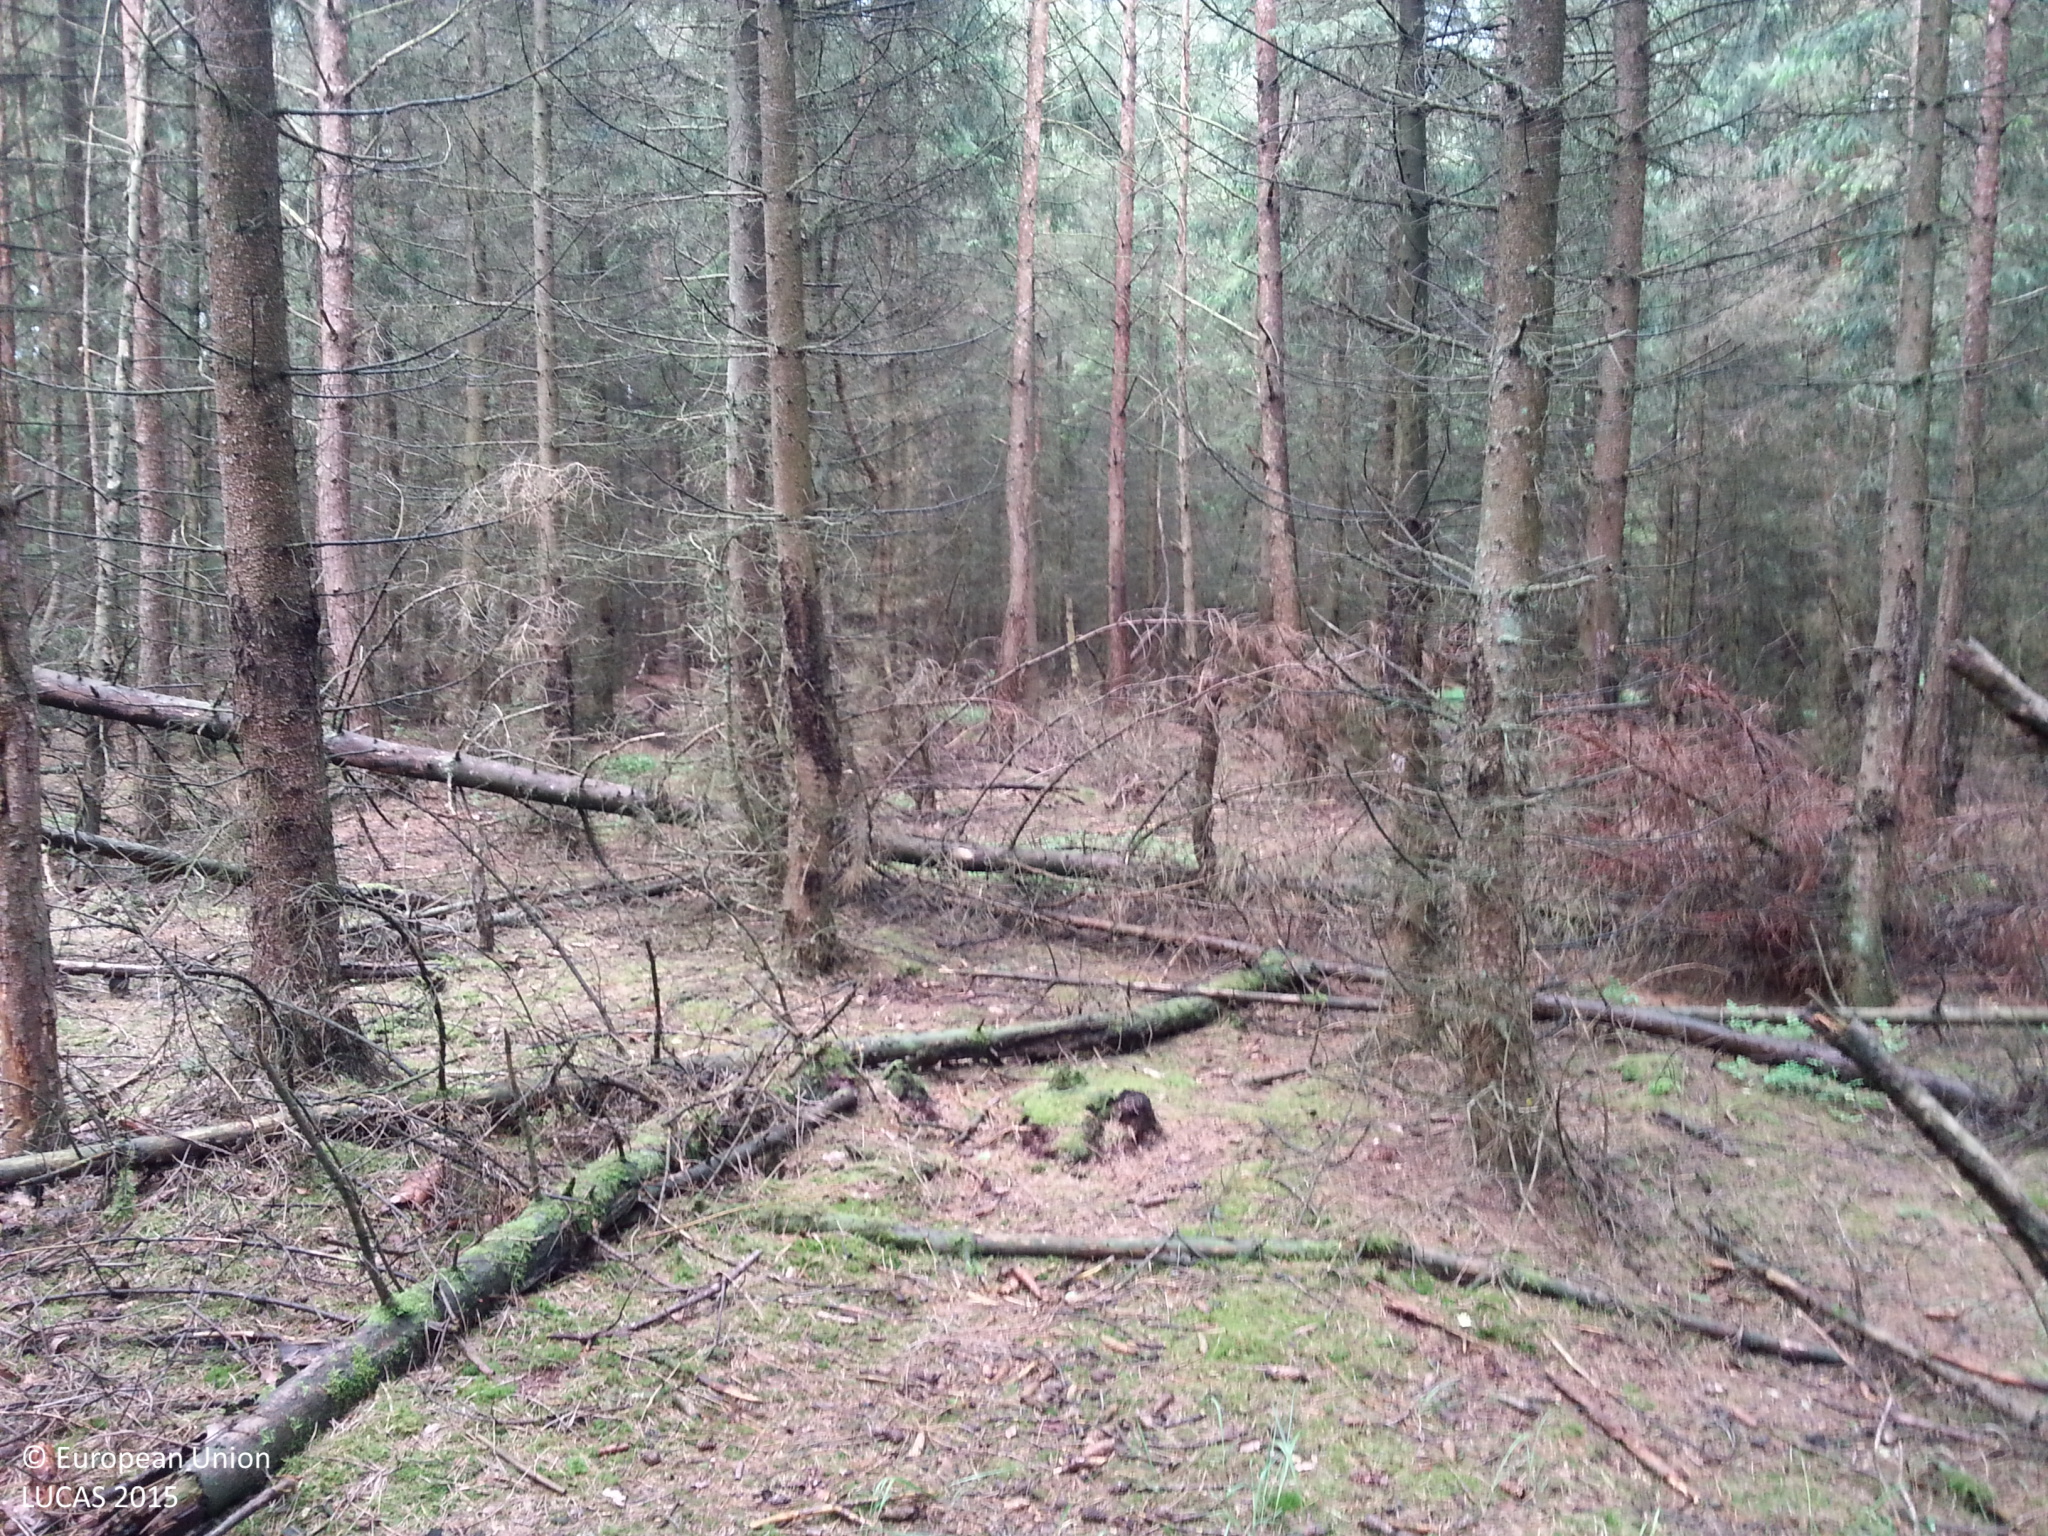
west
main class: Woodland
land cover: Spruce dominated coniferous woodland
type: boreal forest
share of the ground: > 75 %
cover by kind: coniferous forest trees 80 %, lichens and mosses 10 %, unconsolidated bare surface 10 %
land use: Forestry
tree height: > 5 m
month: July
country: DE
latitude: 53.2358
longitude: 11.0333
